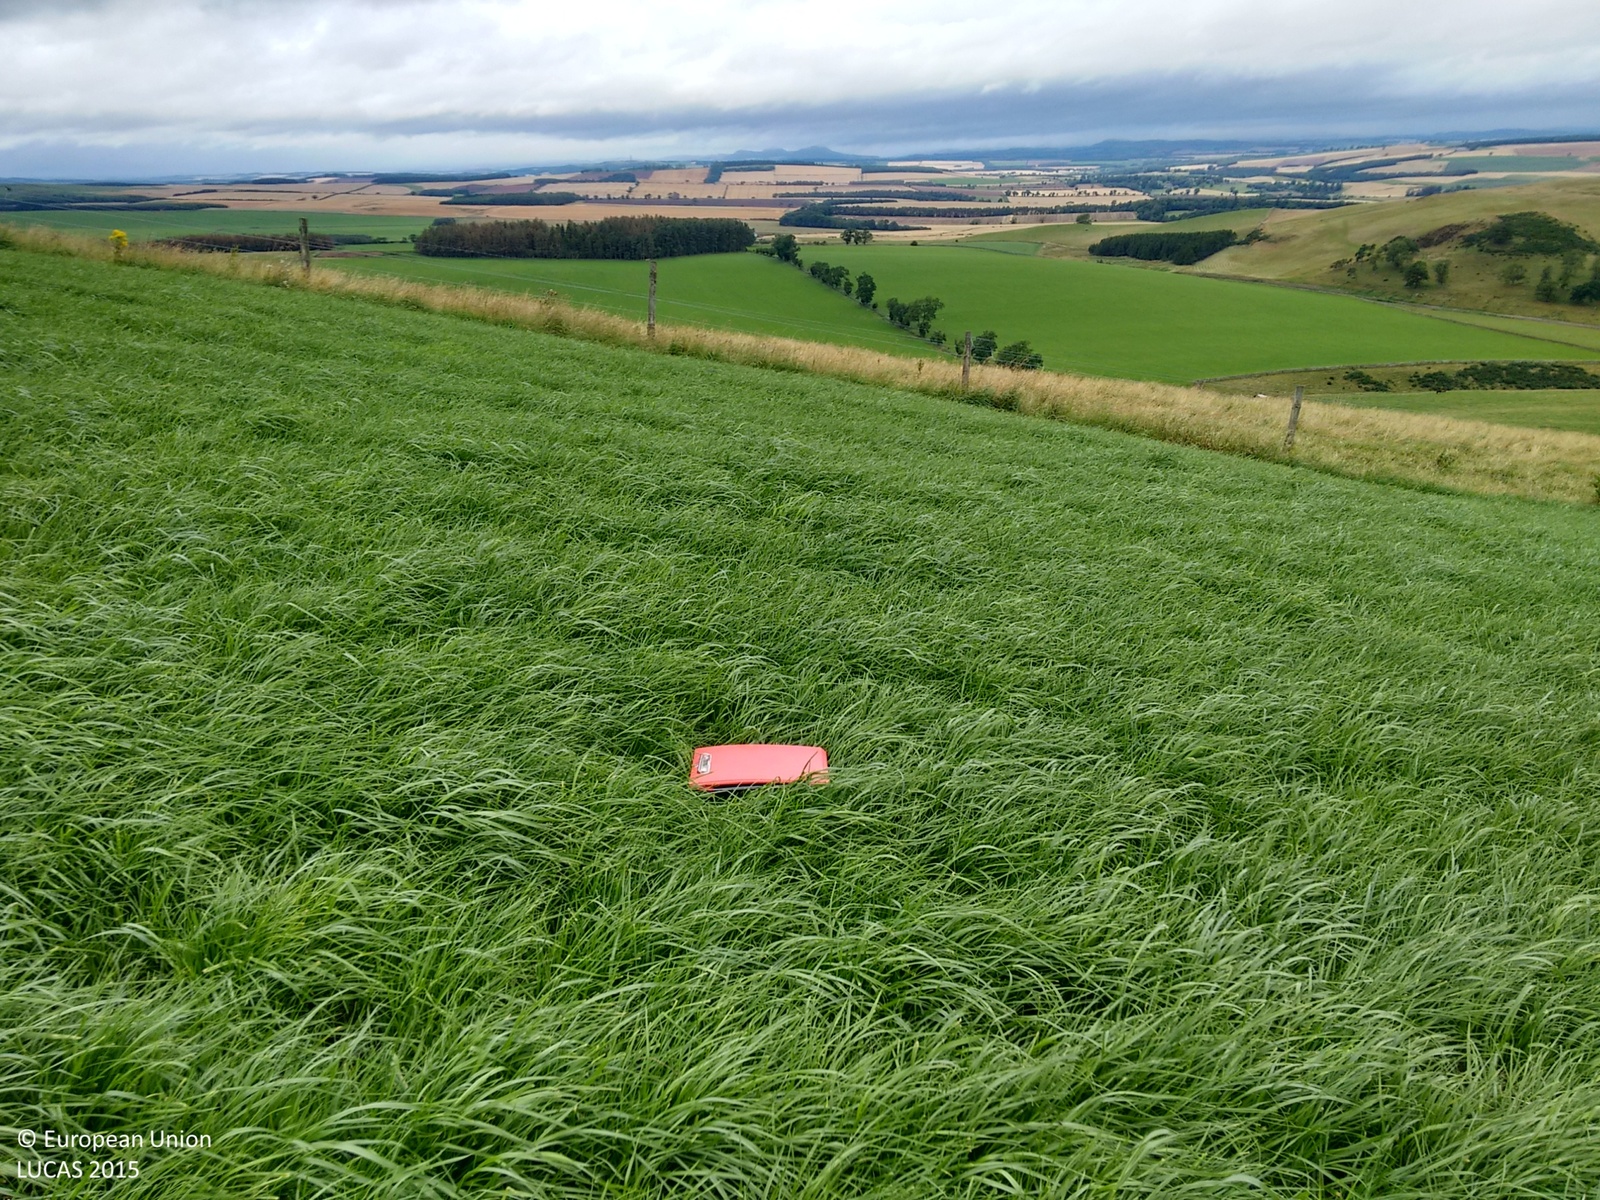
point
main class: Cropland
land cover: Temporary grasslands
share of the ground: > 75 %
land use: Agriculture (excluding fallow land and kitchen gardens)
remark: Harvested field
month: August
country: GB
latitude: 55.4965
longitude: -2.3581
